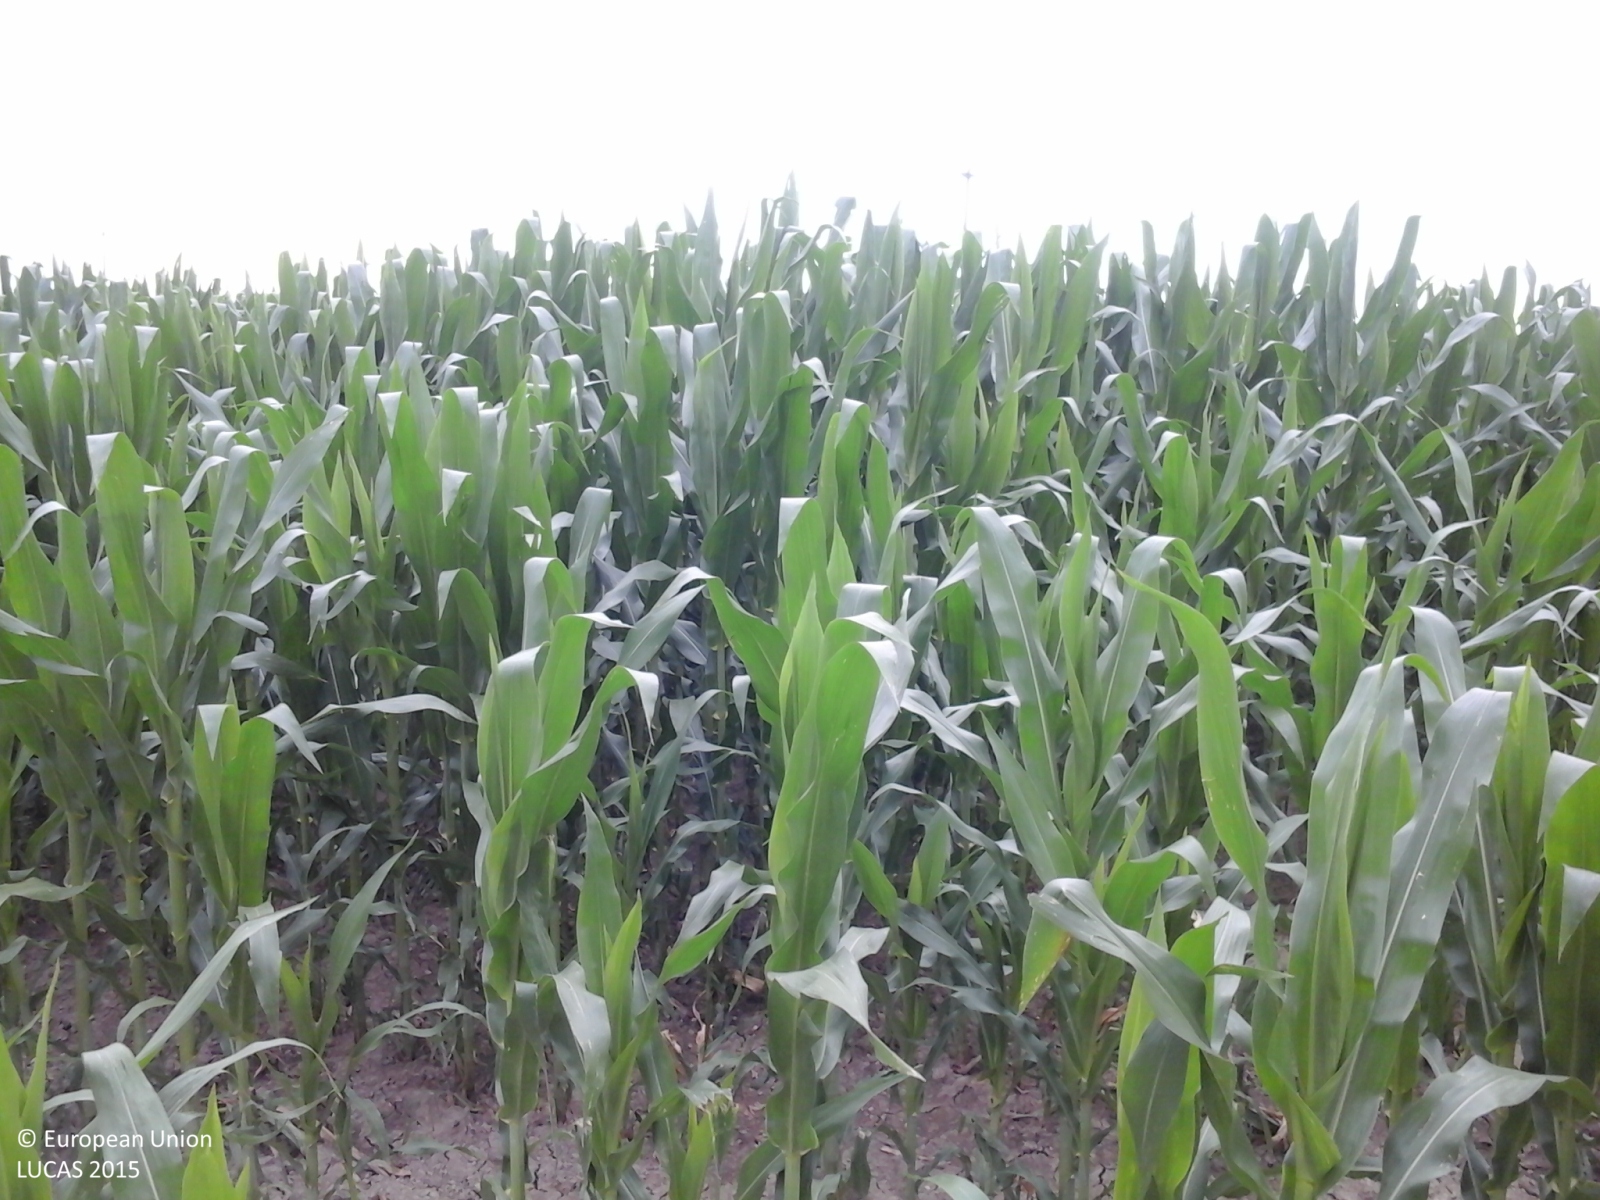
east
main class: Cropland
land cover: Maize
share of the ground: > 75 %
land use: Agriculture (excluding fallow land and kitchen gardens)
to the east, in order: Maize; Ditches and canals; Maize; Ditches and canals; Maize; Ditches and canals; Maize; Ditches and canals; Maize; Ditches and canals; Maize; Ditches and canals; Soya; Ditches and canals; Soya; Grassland without tree/shrub cover; Vineyards
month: June
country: IT
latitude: 45.7234
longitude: 12.6560
